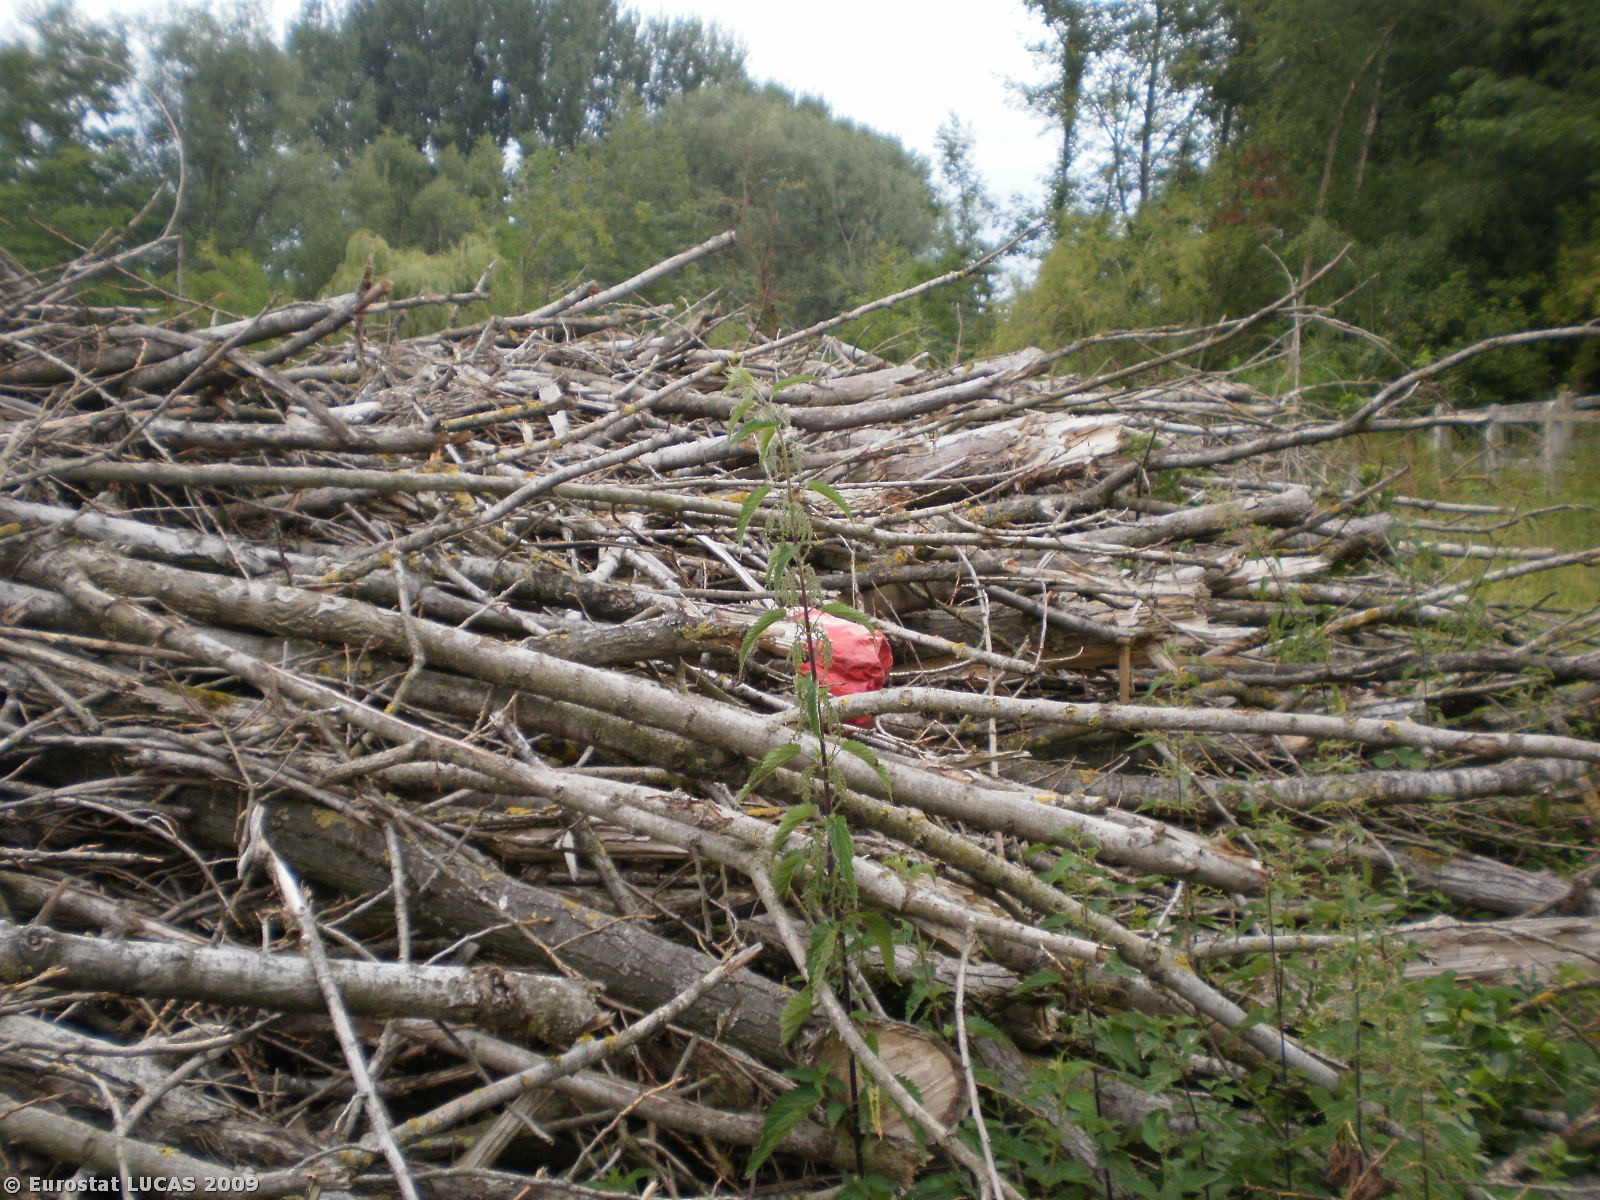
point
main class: Woodland
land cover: Broadleaved woodland
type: acidophilous oak and oak-birch forest
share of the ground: > 75 %
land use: Forestry
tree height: > 5 m
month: July
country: BE
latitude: 50.9009
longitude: 4.1790
